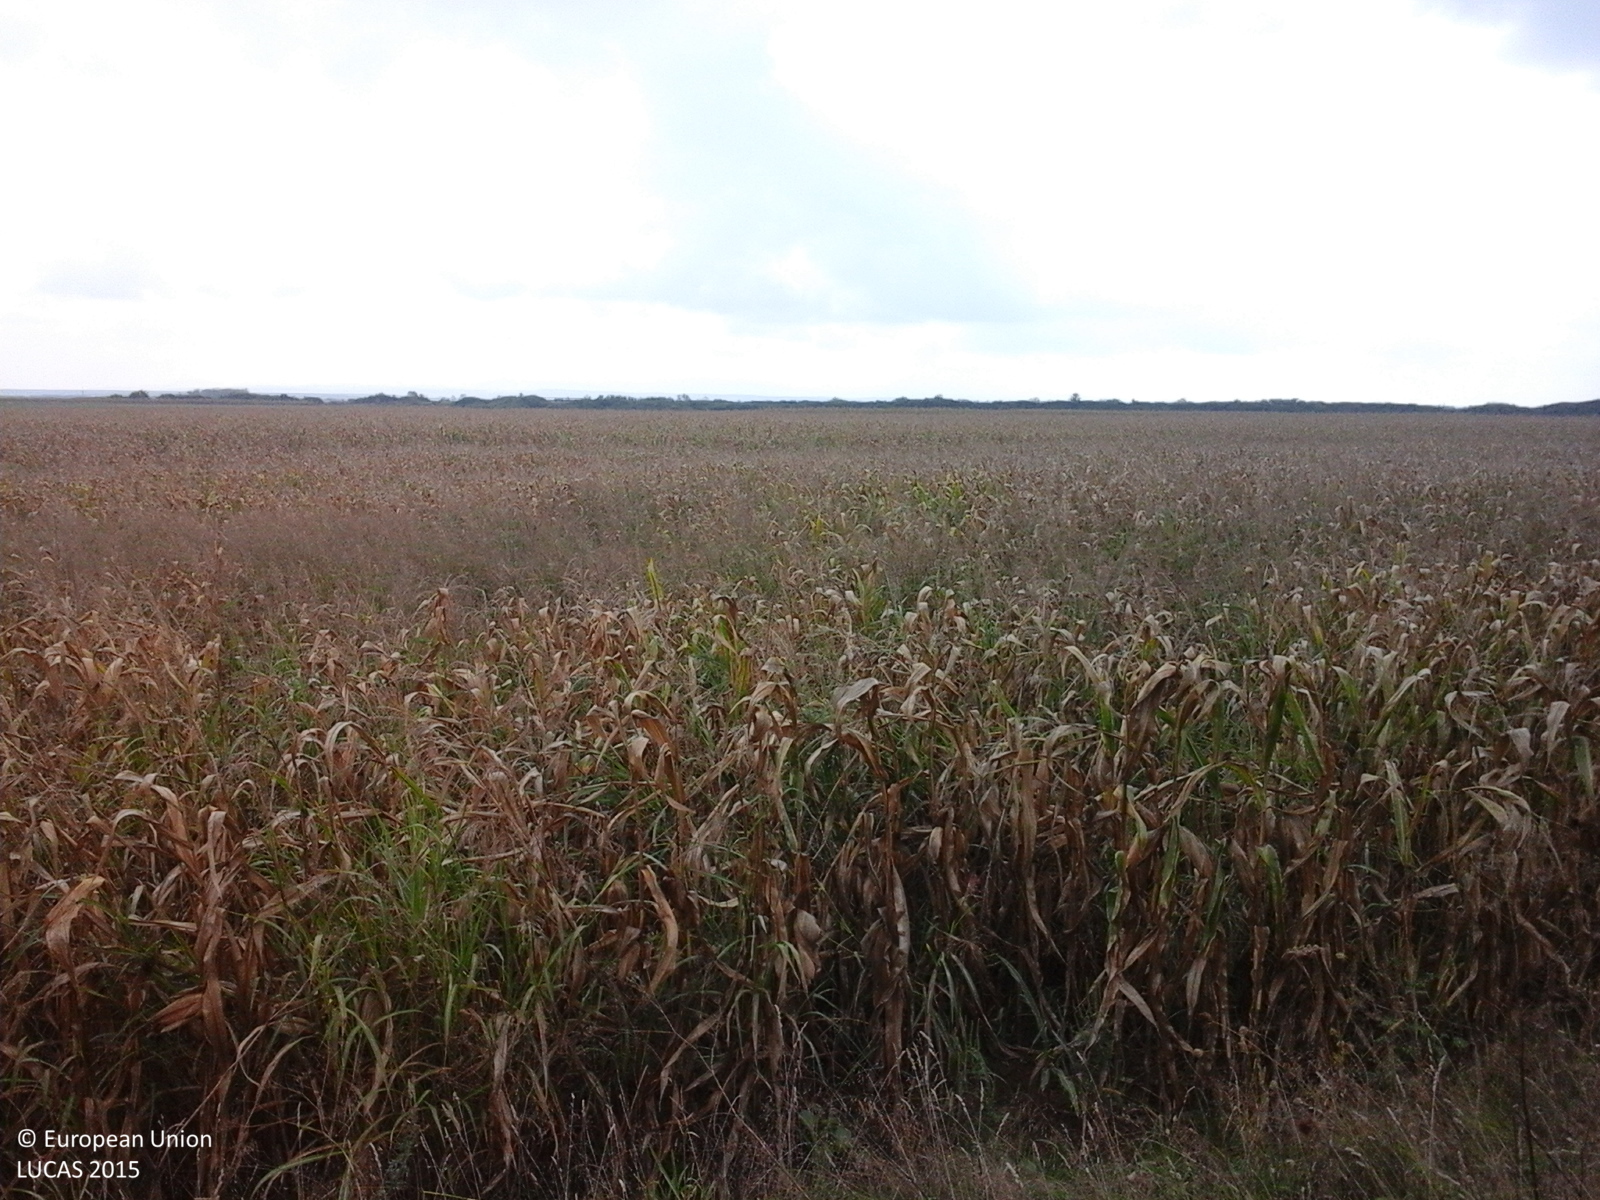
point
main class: Cropland
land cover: Maize
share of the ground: > 75 %
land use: Agriculture (excluding fallow land and kitchen gardens)
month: September
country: RO
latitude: 46.7111
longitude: 21.8291
